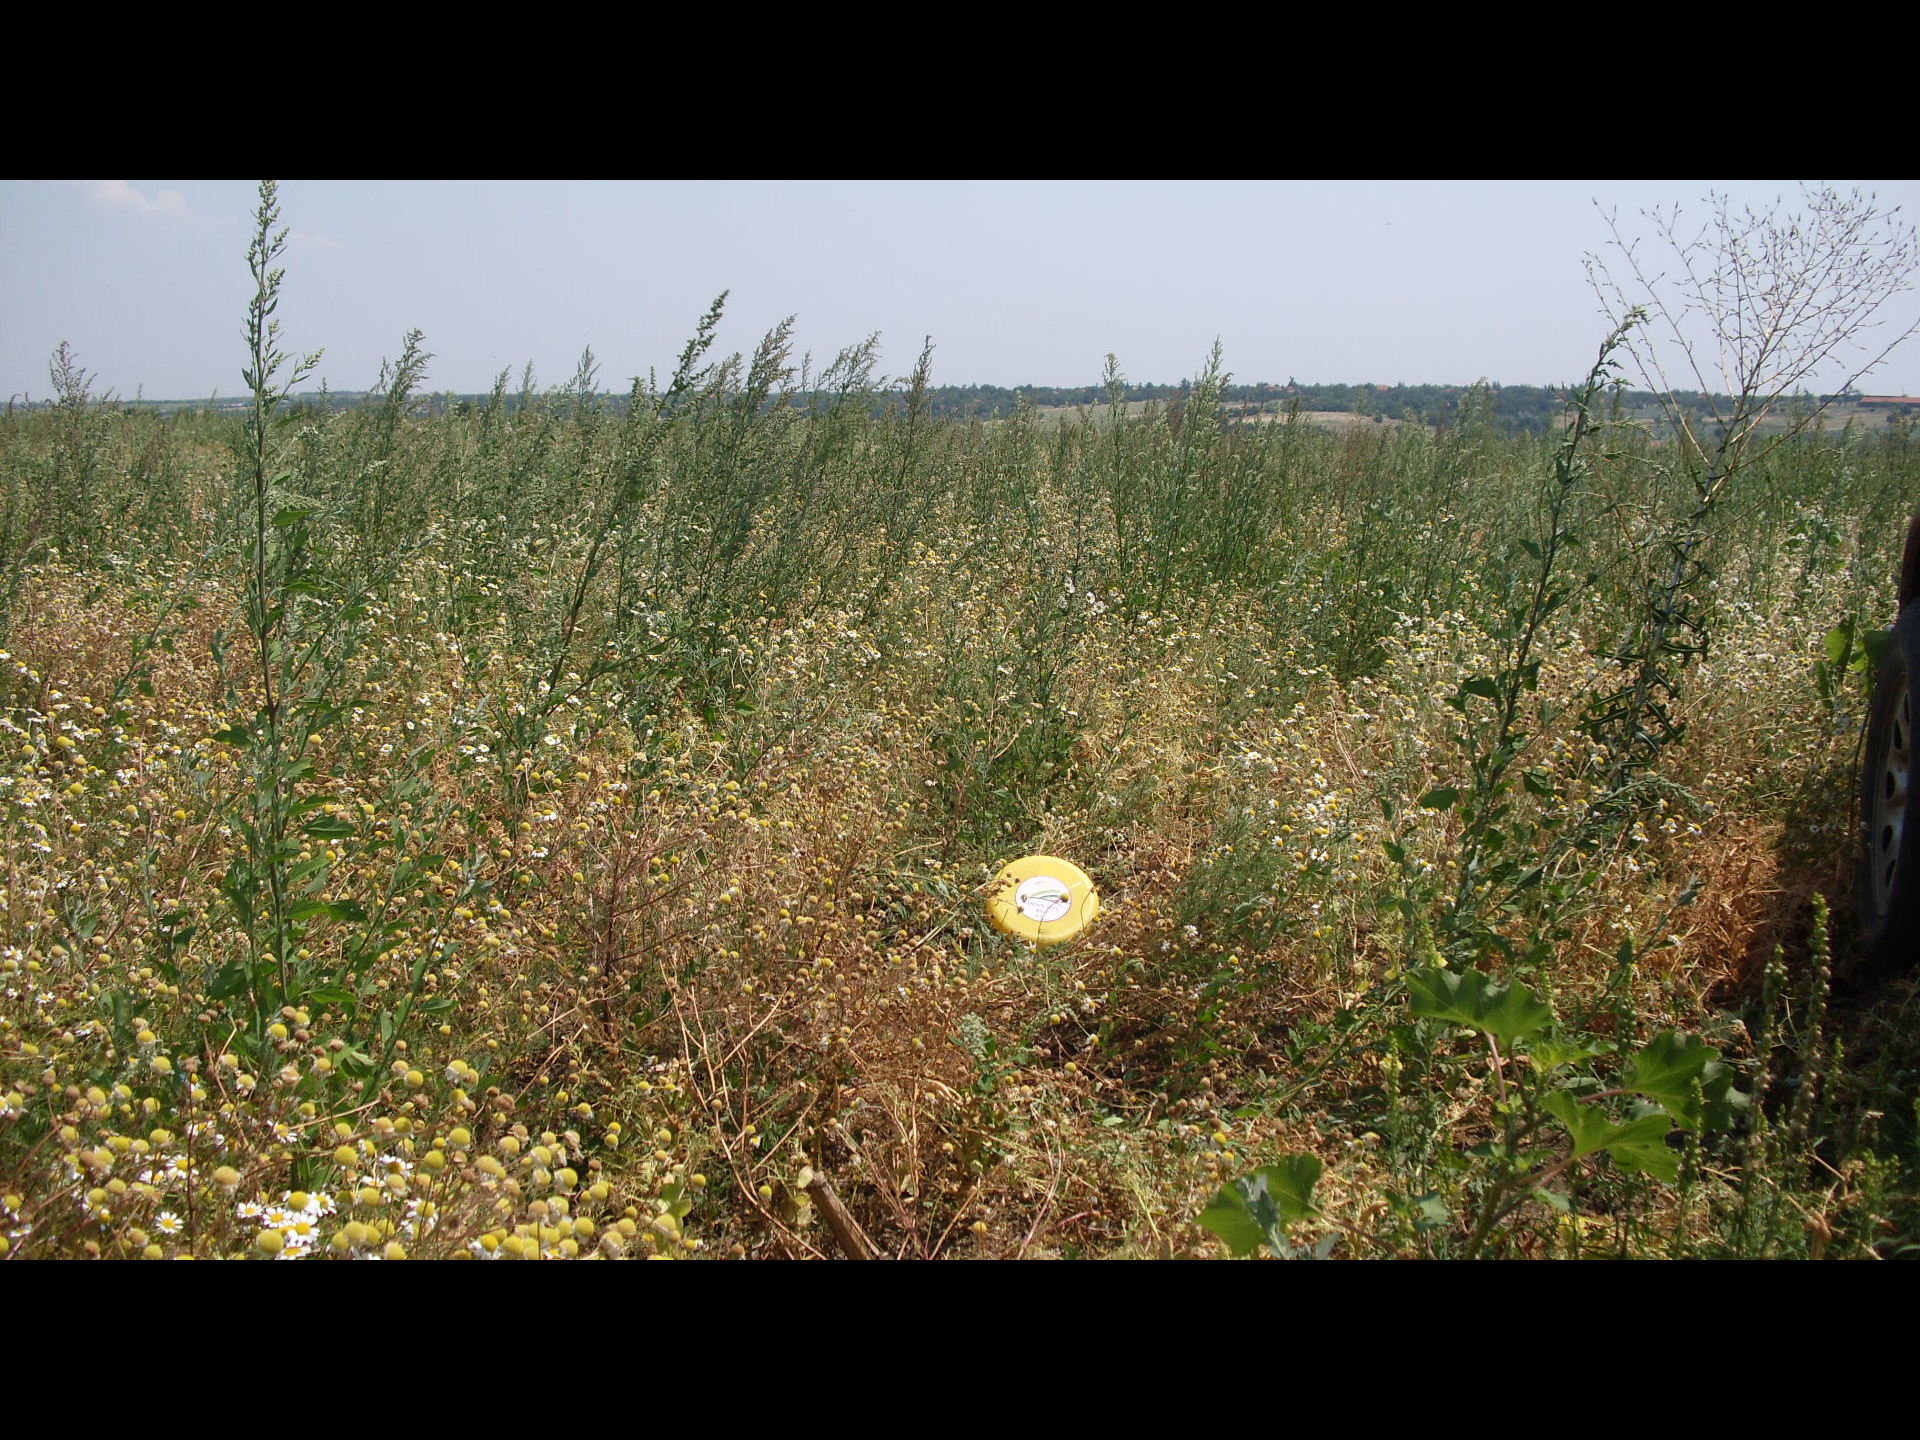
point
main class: Grassland
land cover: Spontaneously vegetated surfaces
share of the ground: > 75 %
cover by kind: herbaceous plants 100 %
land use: Fallow land
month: July
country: BG
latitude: 43.8158
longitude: 22.6036
